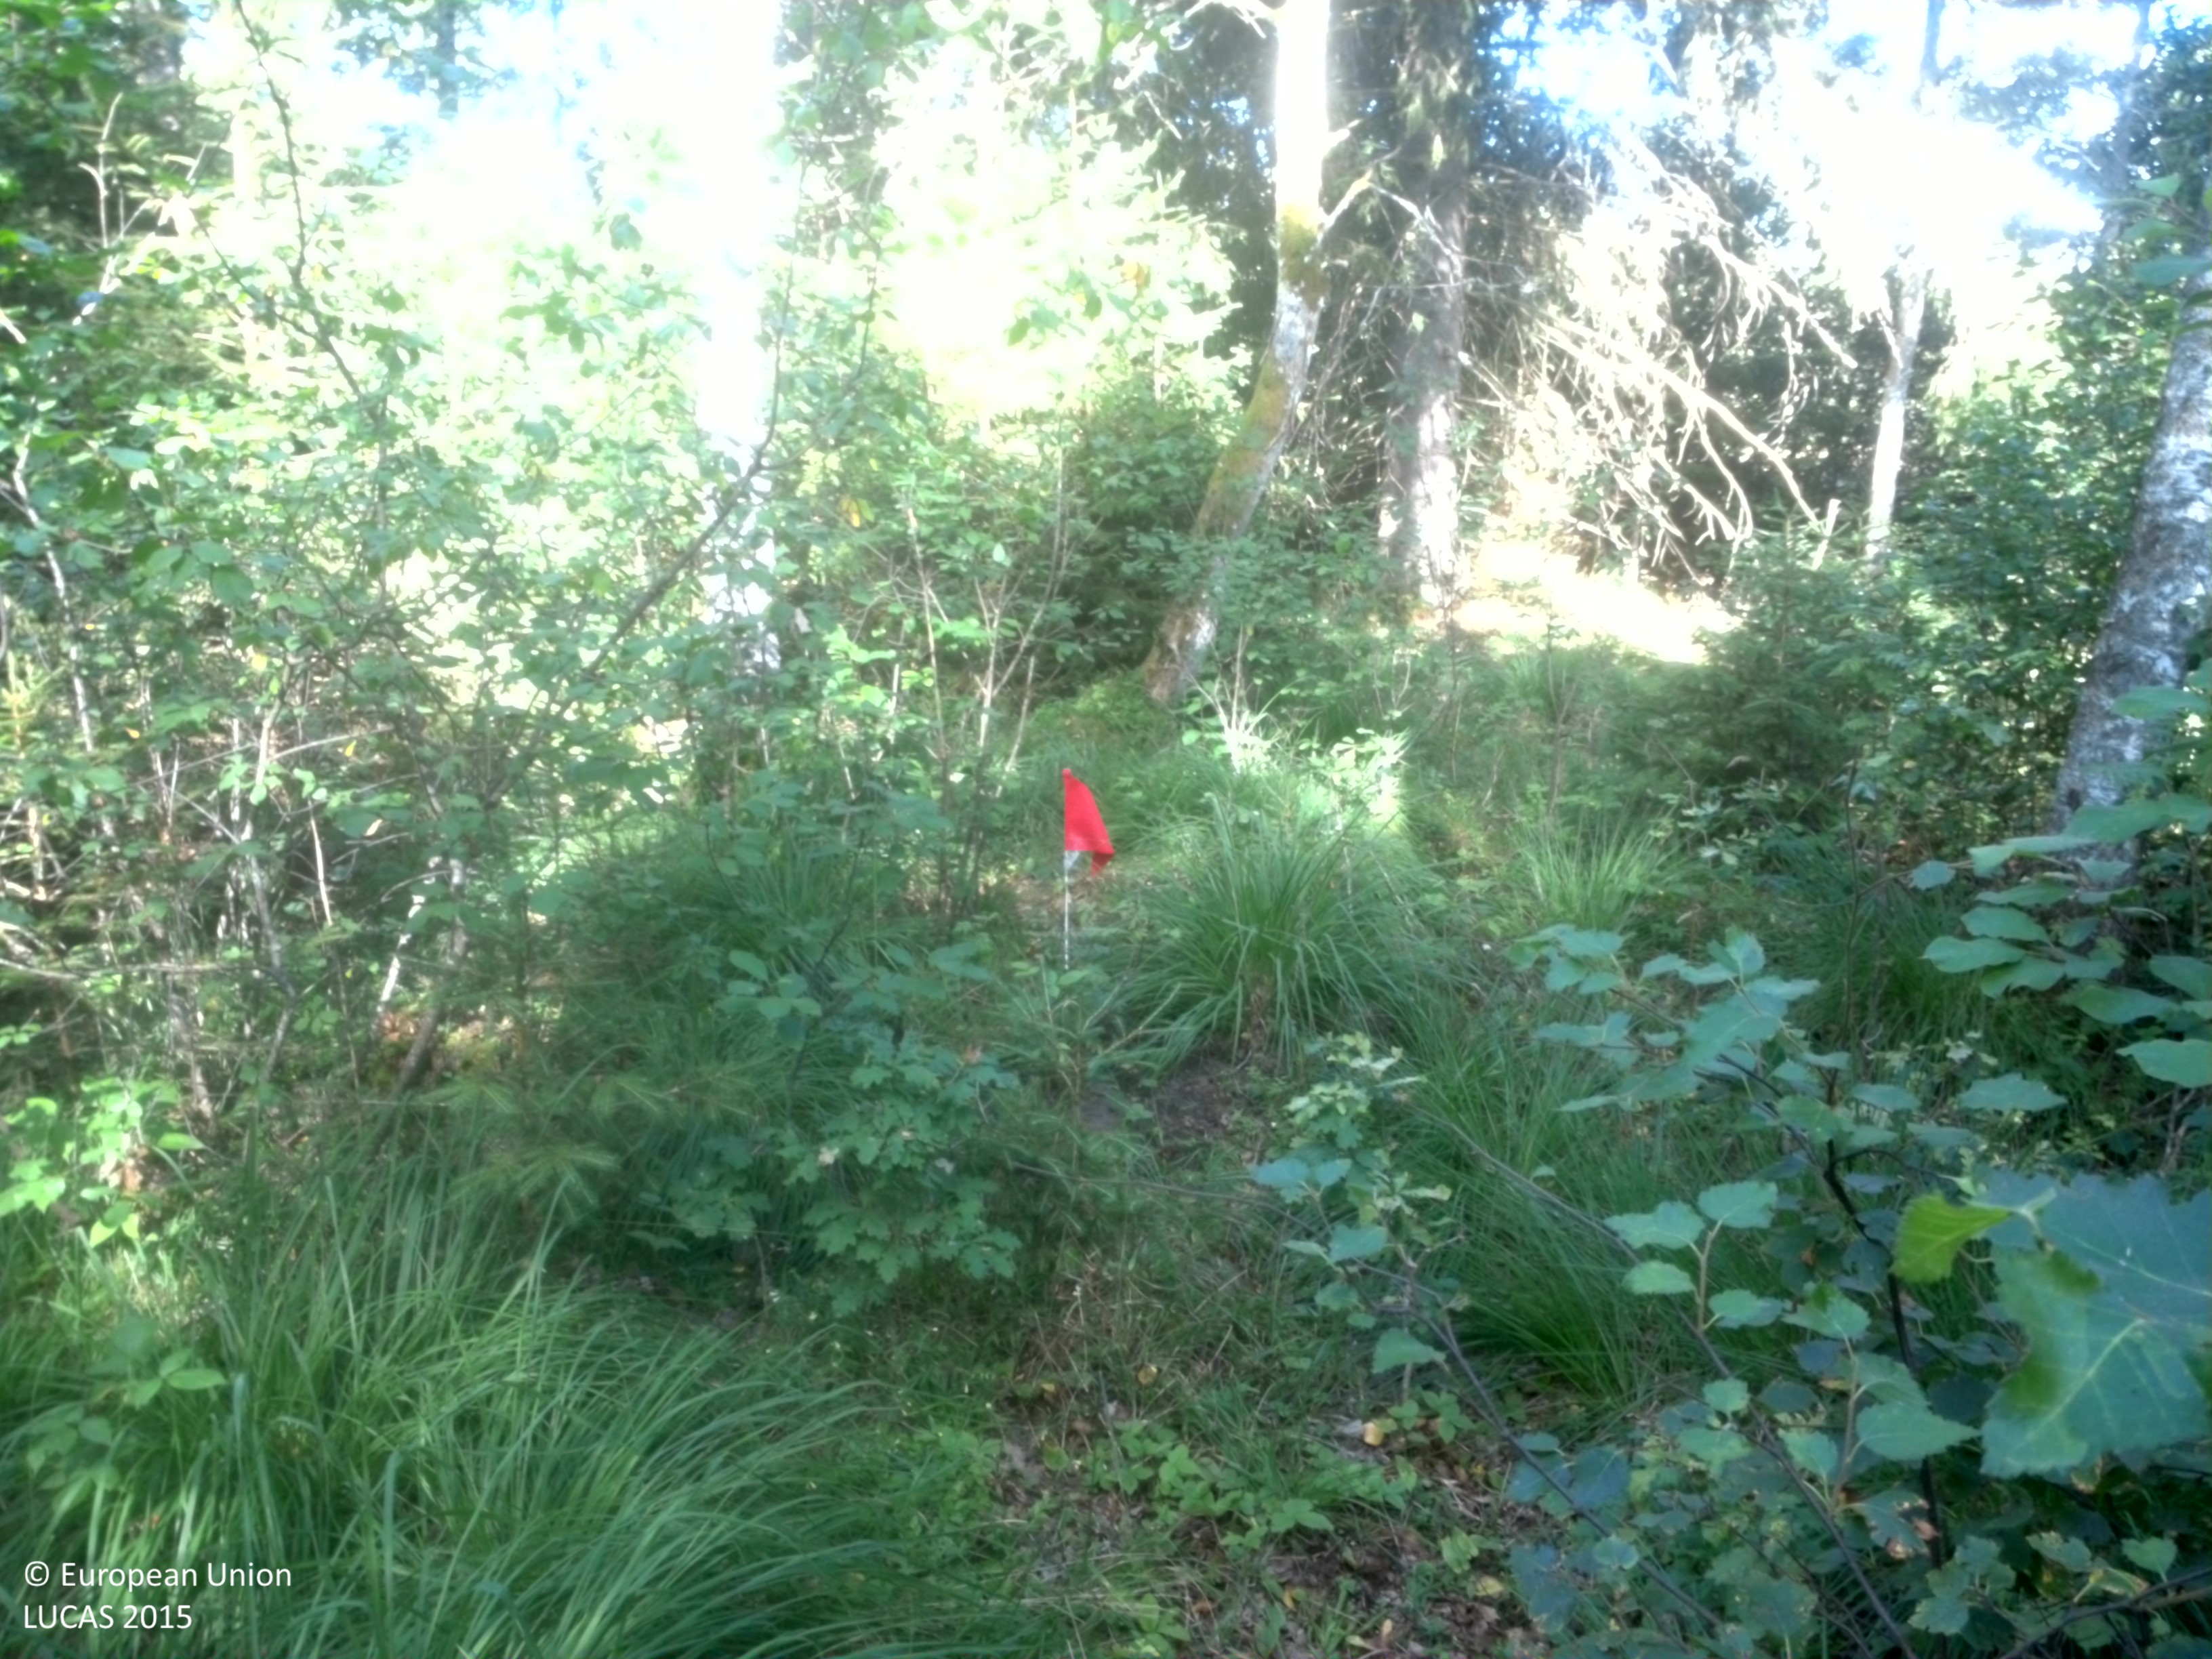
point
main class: Woodland
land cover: Broadleaved woodland
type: boreal forest
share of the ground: 50 - 75 %
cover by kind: broadleaved forest trees 55 %, herbaceous plants 35 %, coniferous forest trees 5 %, shrubs 5 %
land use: Forestry
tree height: > 5 m
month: August
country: SE
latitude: 58.2865
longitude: 13.3203
